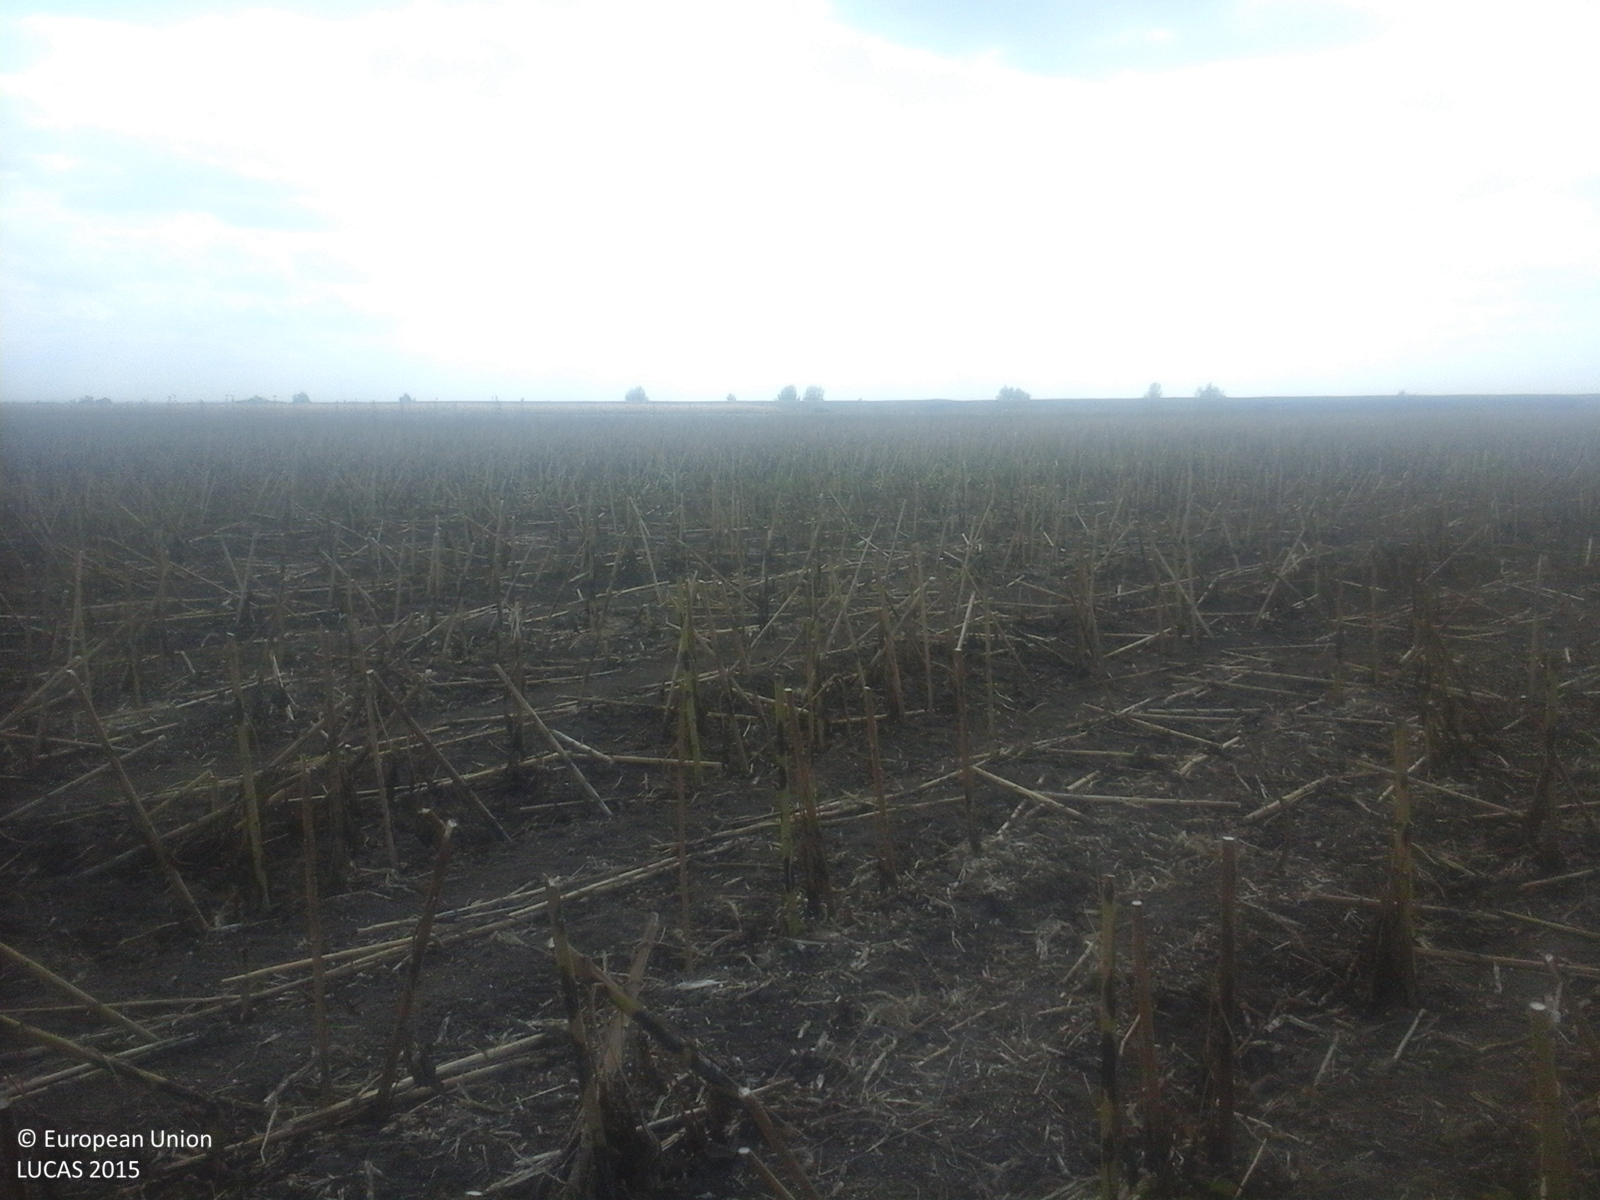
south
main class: Cropland
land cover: Sunflower
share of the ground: > 75 %
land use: Agriculture (excluding fallow land and kitchen gardens)
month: September
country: RO
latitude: 47.6677
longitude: 22.6994
